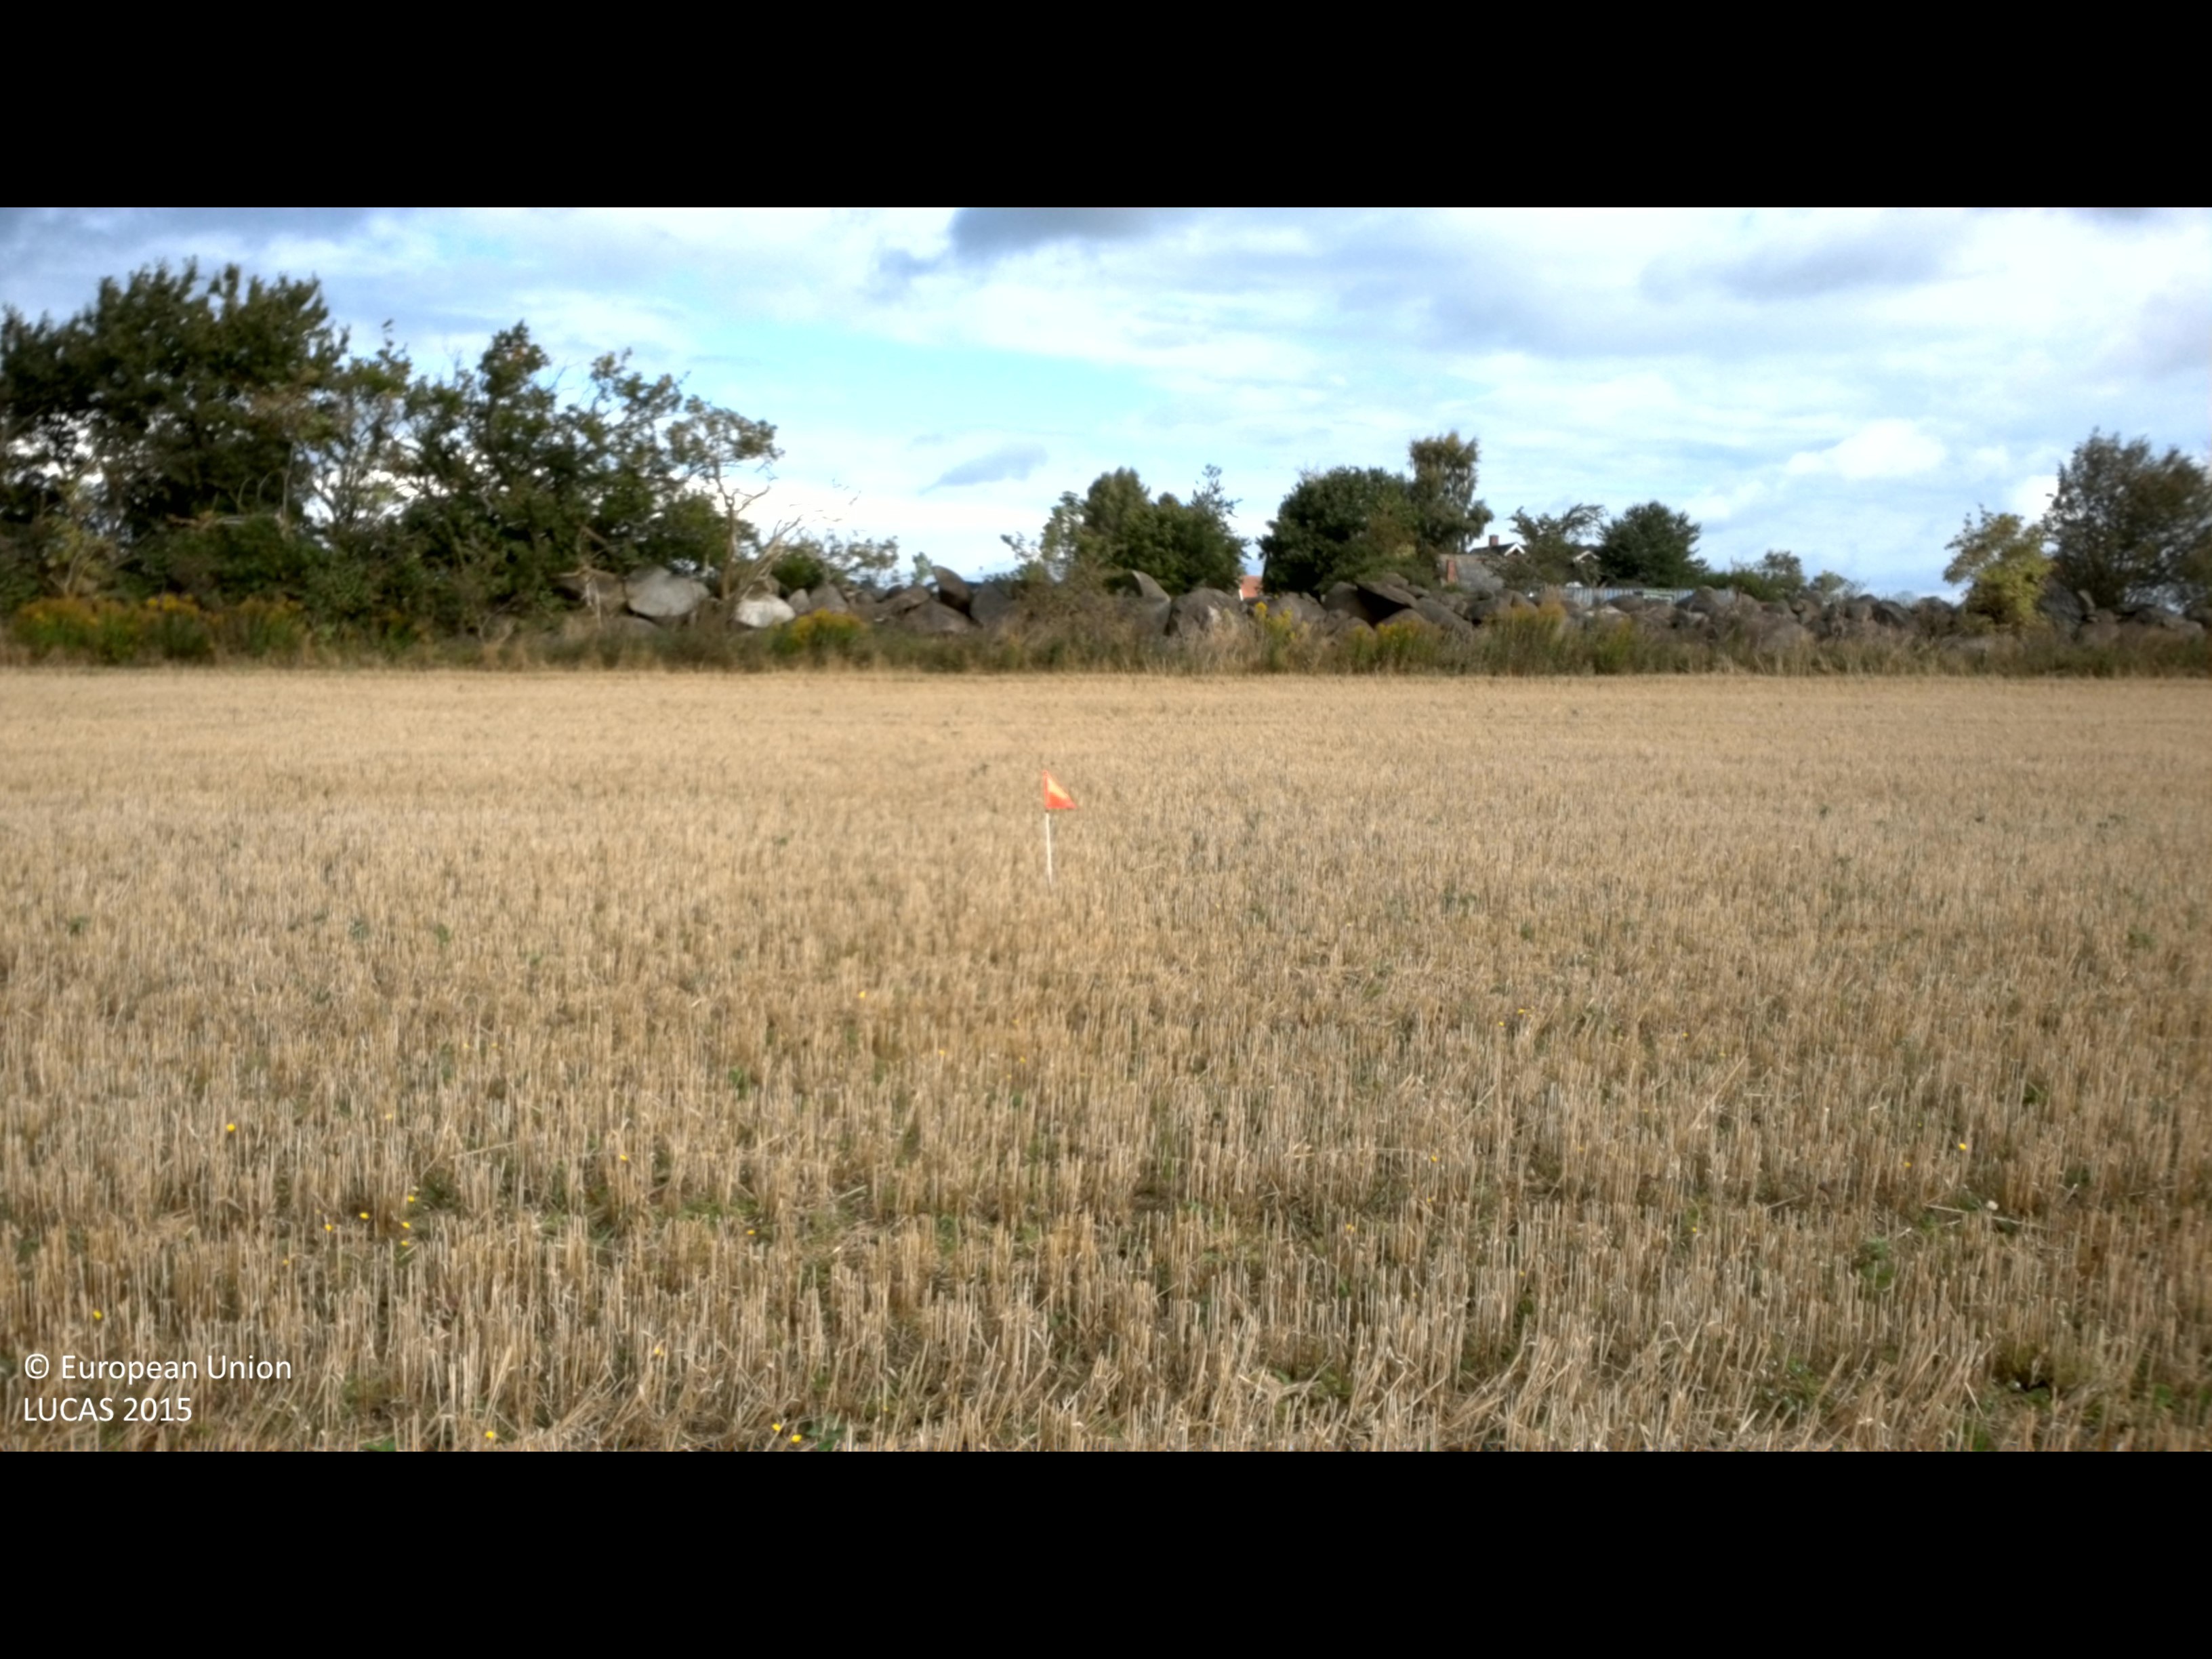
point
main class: Cropland
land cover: Barley
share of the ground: > 75 %
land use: Agriculture (excluding fallow land and kitchen gardens)
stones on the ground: < 10 %
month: September
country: SE
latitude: 56.0633
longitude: 14.2541
